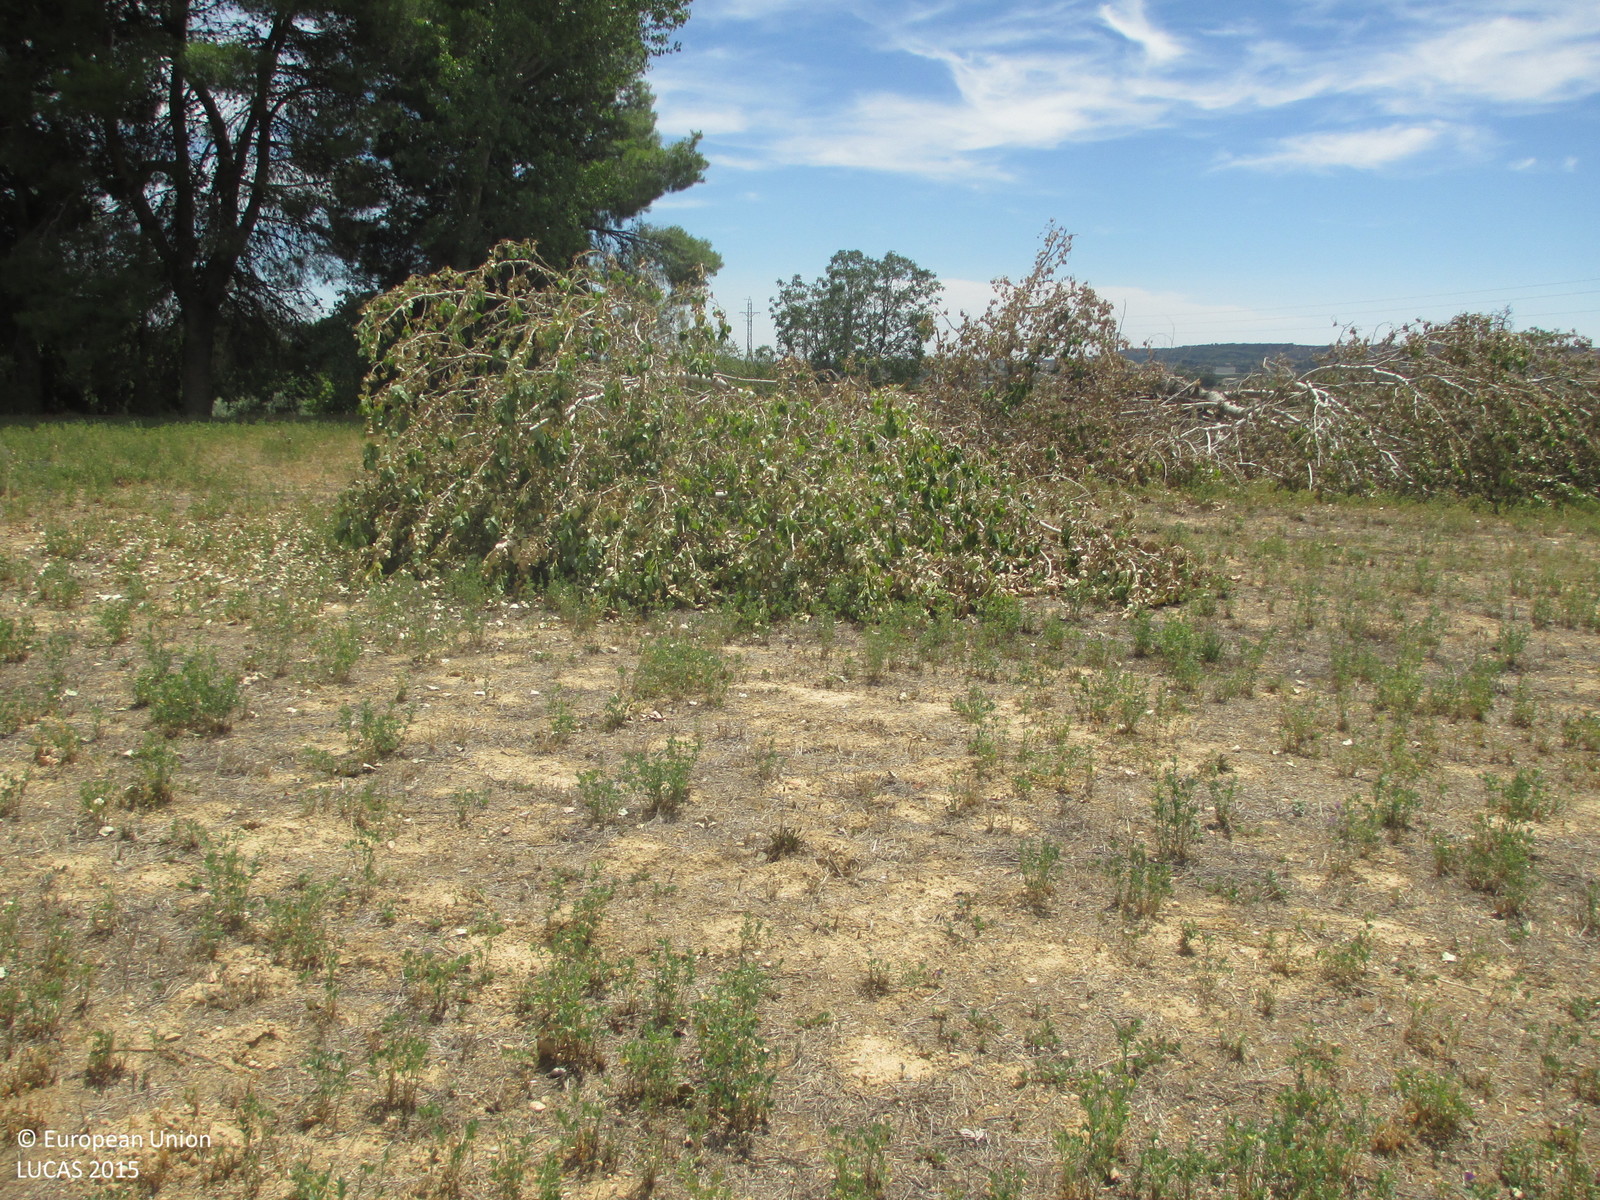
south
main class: Cropland
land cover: Lucerne
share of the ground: > 75 %
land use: Agriculture (excluding fallow land and kitchen gardens)
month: July
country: ES
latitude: 41.8768
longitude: 0.2840
